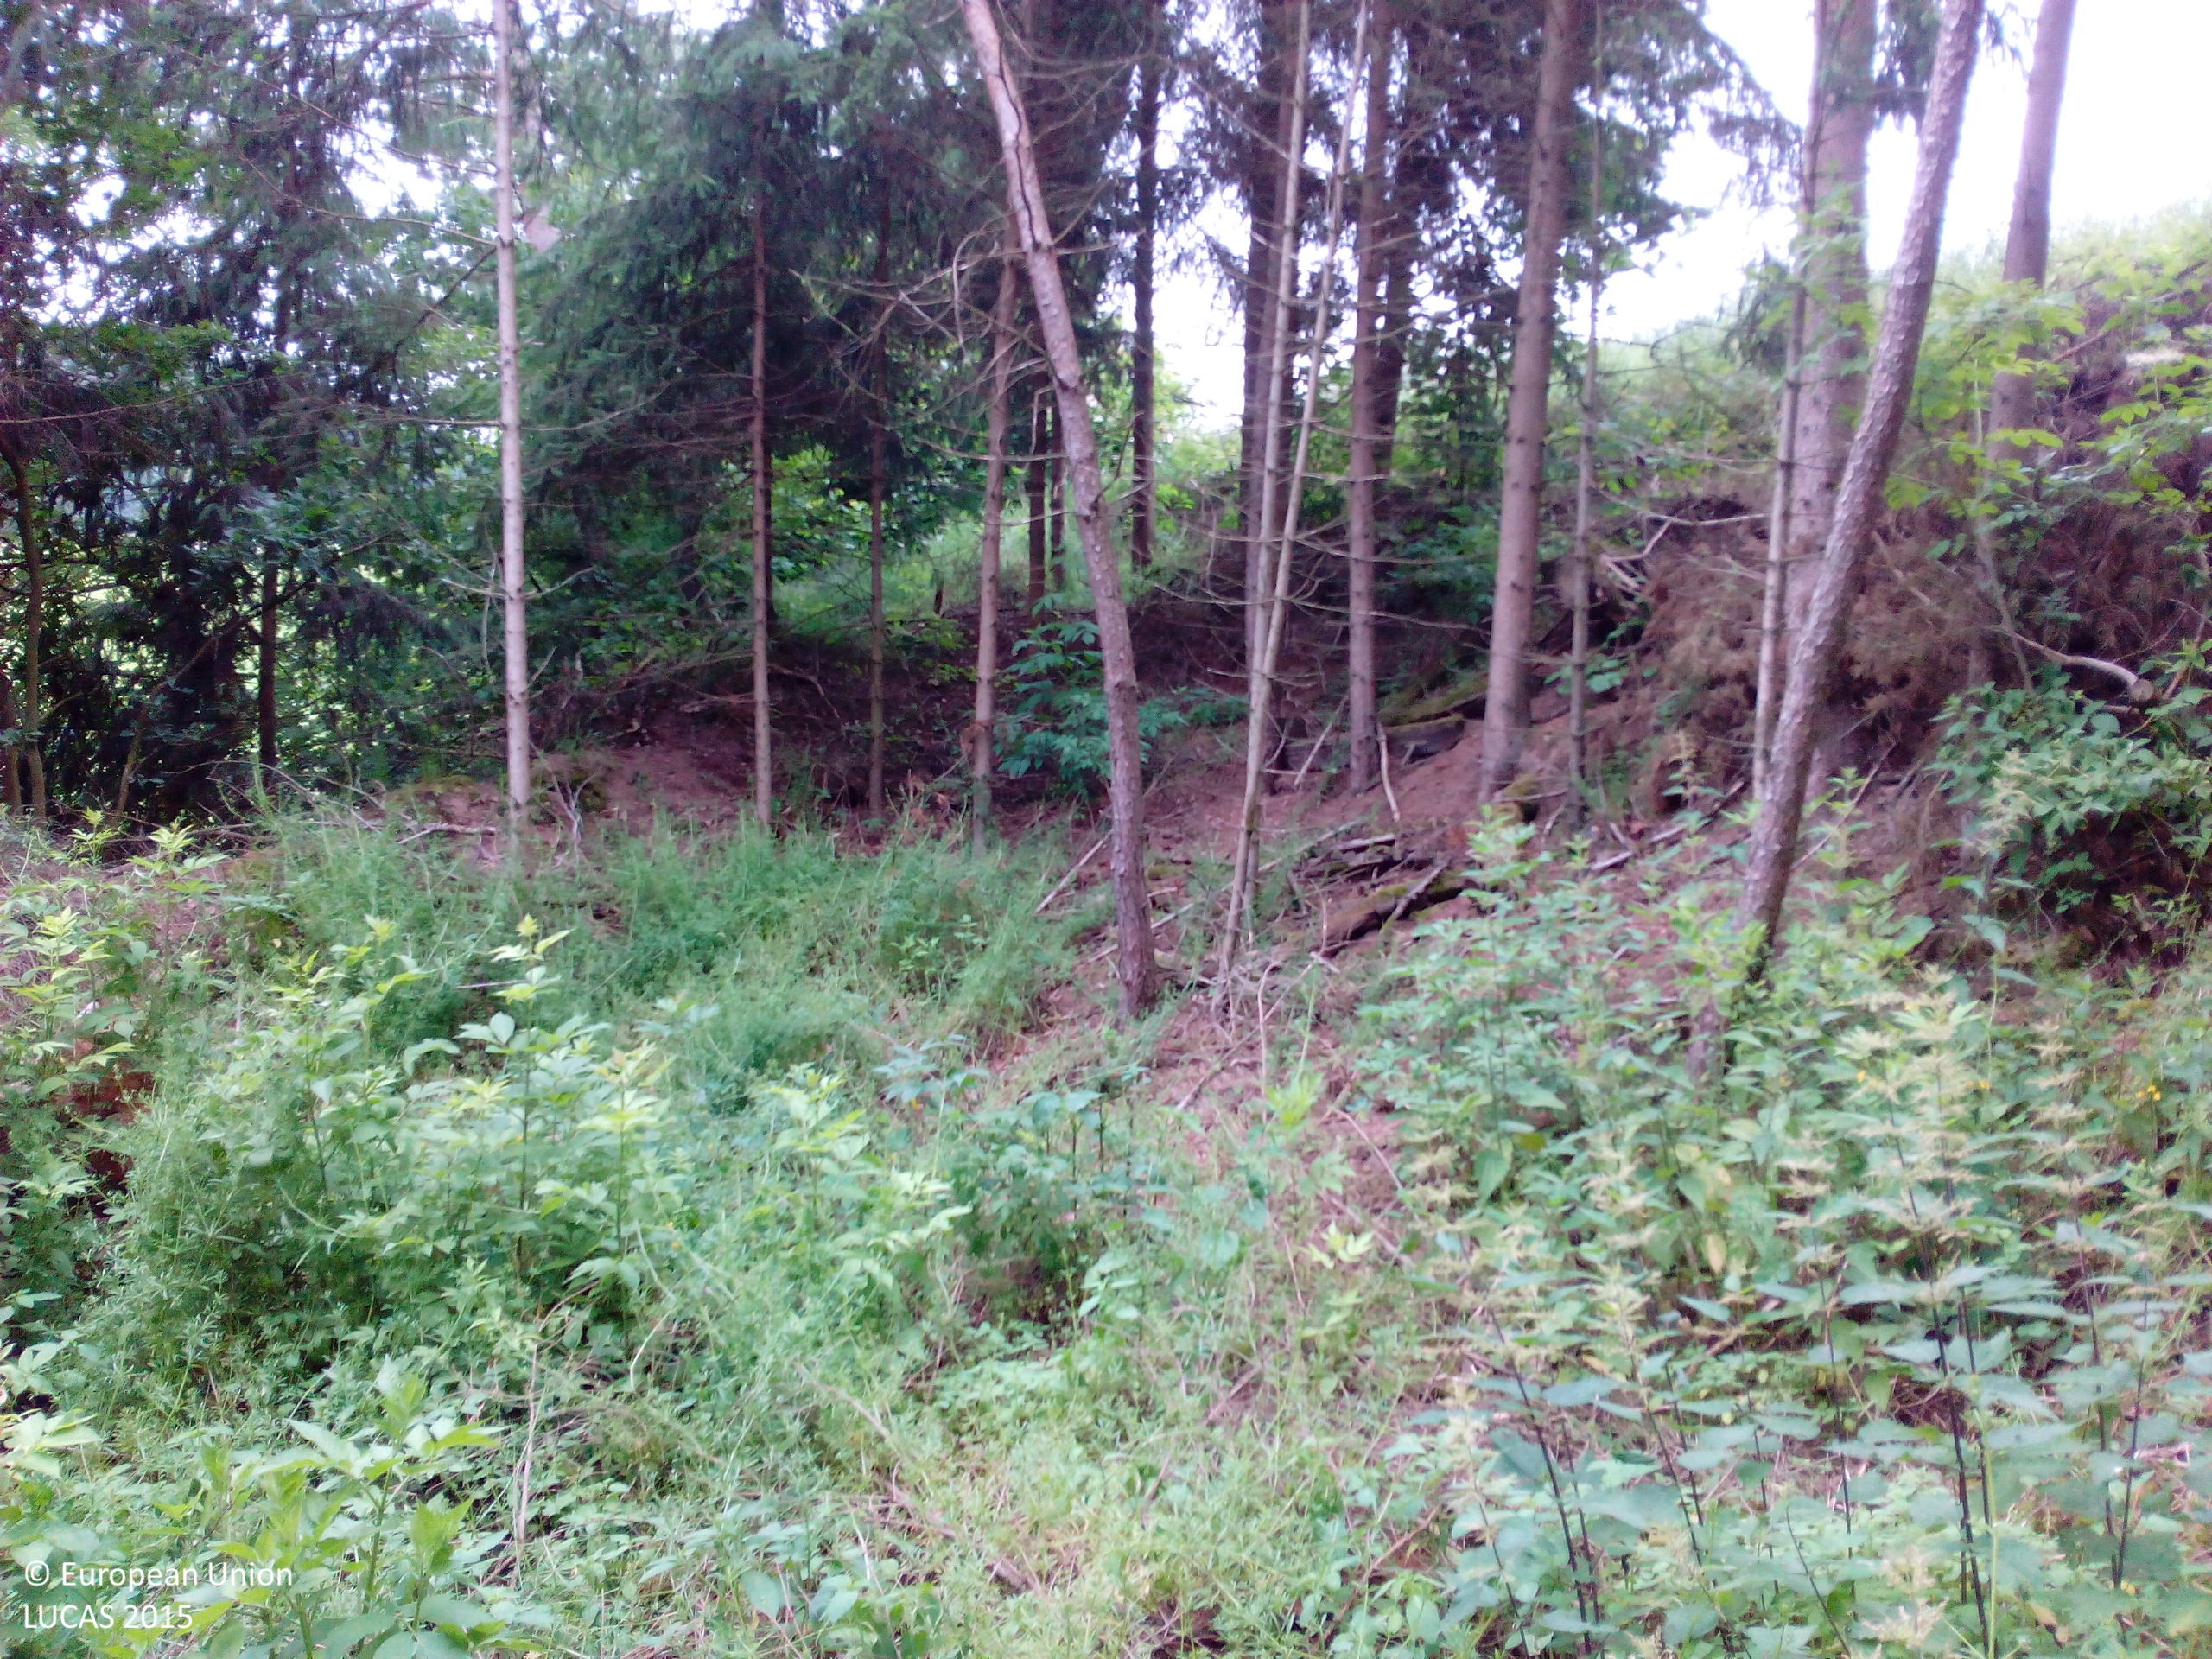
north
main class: Woodland
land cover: Pine dominated coniferous woodland
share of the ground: 25 - 50 %
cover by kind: herbaceous plants 40 %, coniferous forest trees 30 %, lichens and mosses 15 %, unconsolidated bare surface 15 %
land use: Forestry
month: June
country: DE
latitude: 49.0789
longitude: 12.4226
